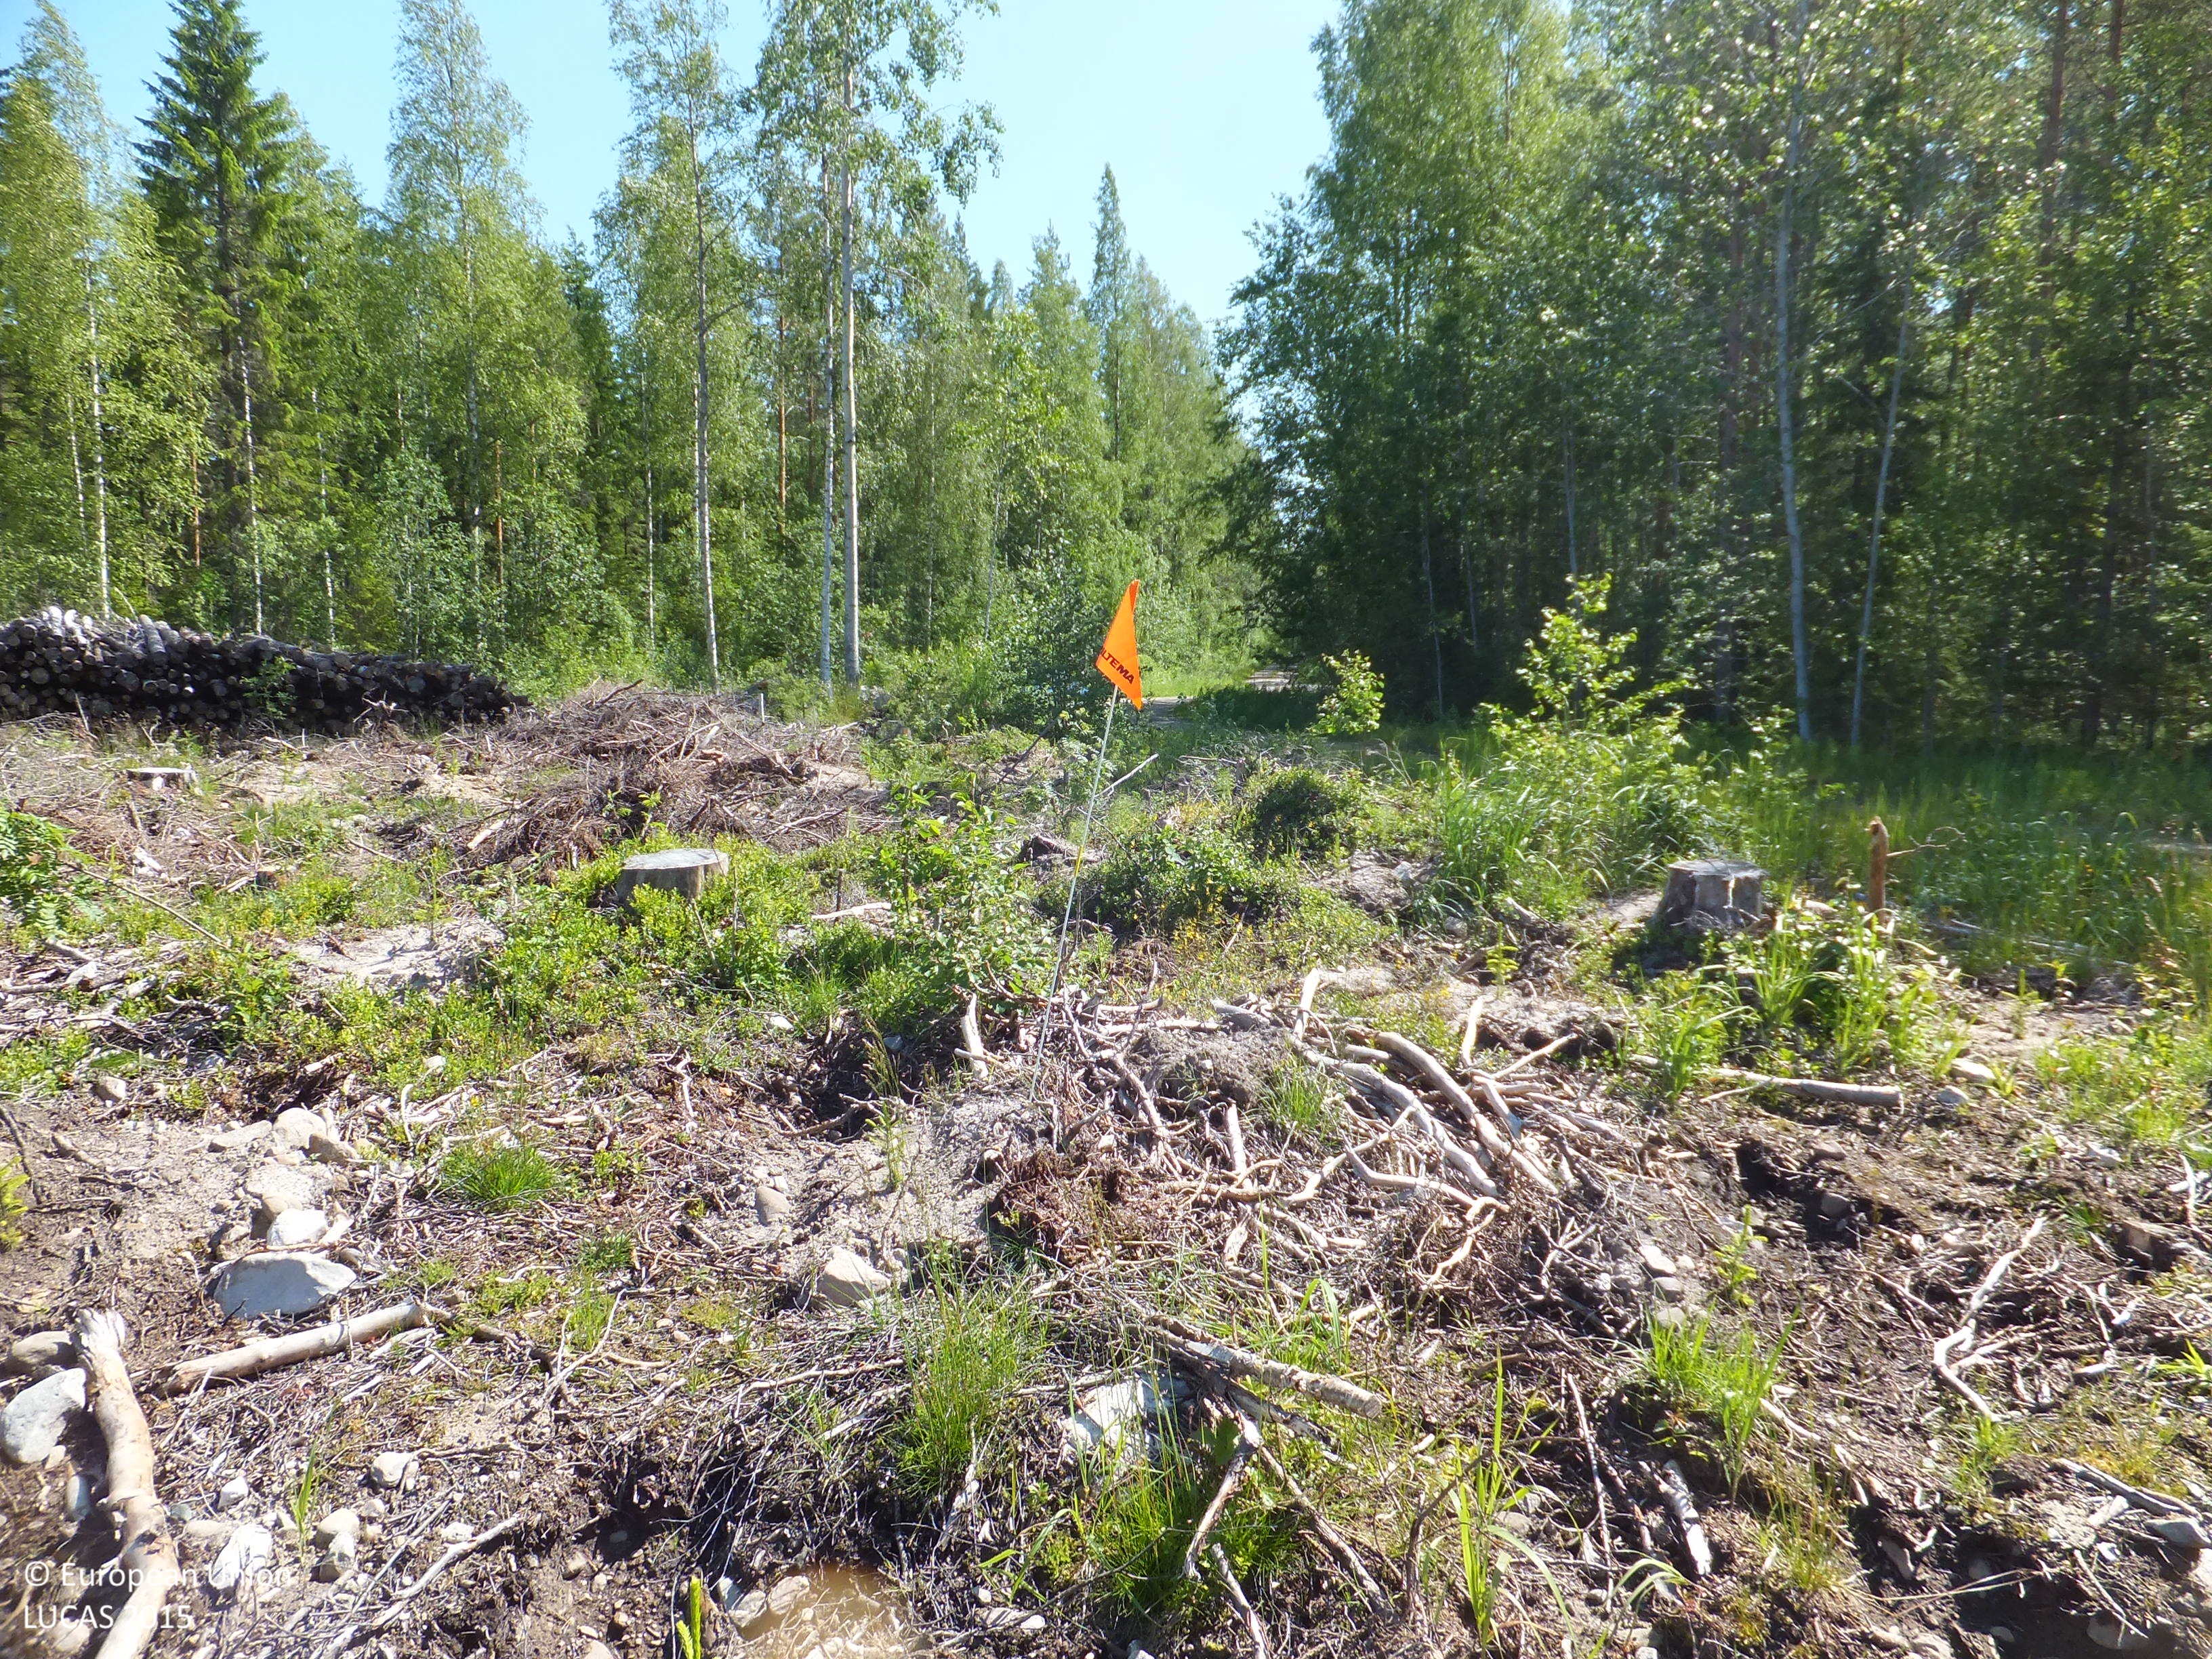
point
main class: Shrubland
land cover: Shrubland without tree cover
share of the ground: 50 - 75 %
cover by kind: shrubs 30 %, unconsolidated bare surface 30 %, herbaceous plants 10 %, consolidated bare surface 10 %
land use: Forestry
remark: Clear cut
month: July
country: FI
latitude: 63.1352
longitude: 24.1400
